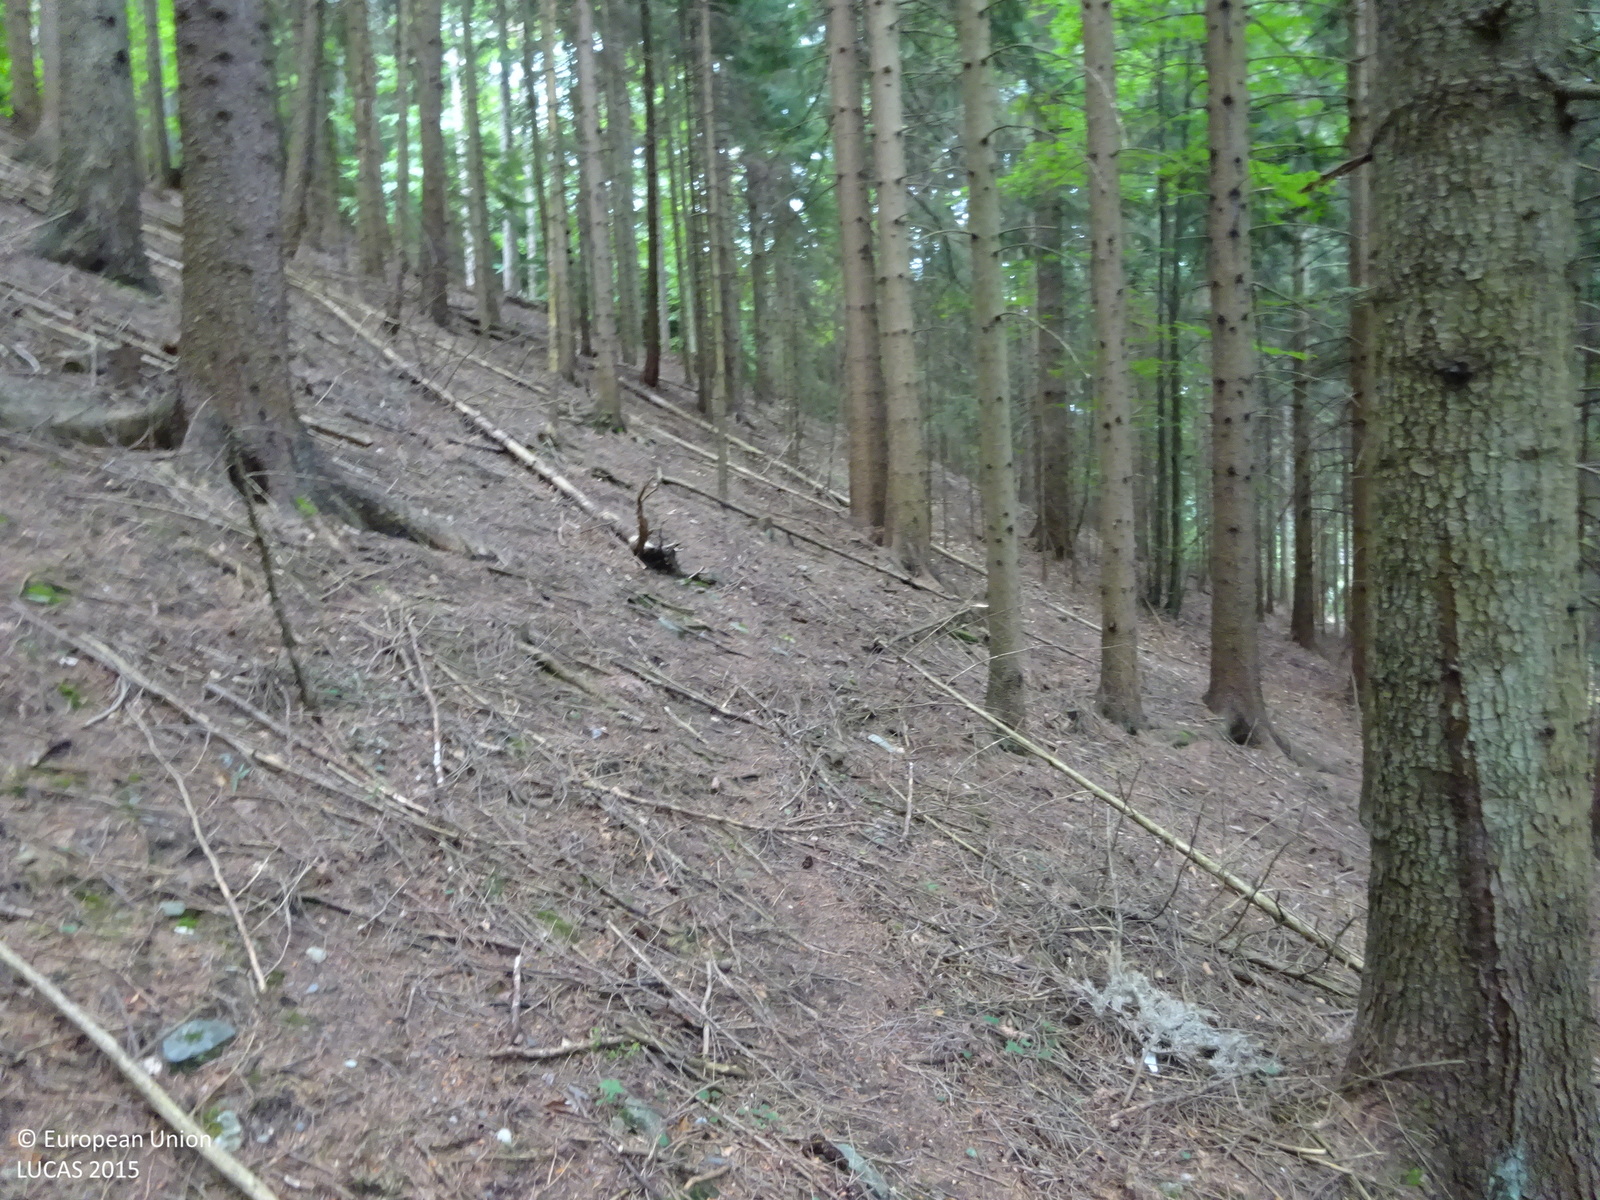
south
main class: Woodland
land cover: Spruce dominated coniferous woodland
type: alpine coniferous forest
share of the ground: > 75 %
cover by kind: coniferous forest trees 100 %
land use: Forestry
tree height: > 5 m
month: July
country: AT
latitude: 47.1881
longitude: 15.4242
